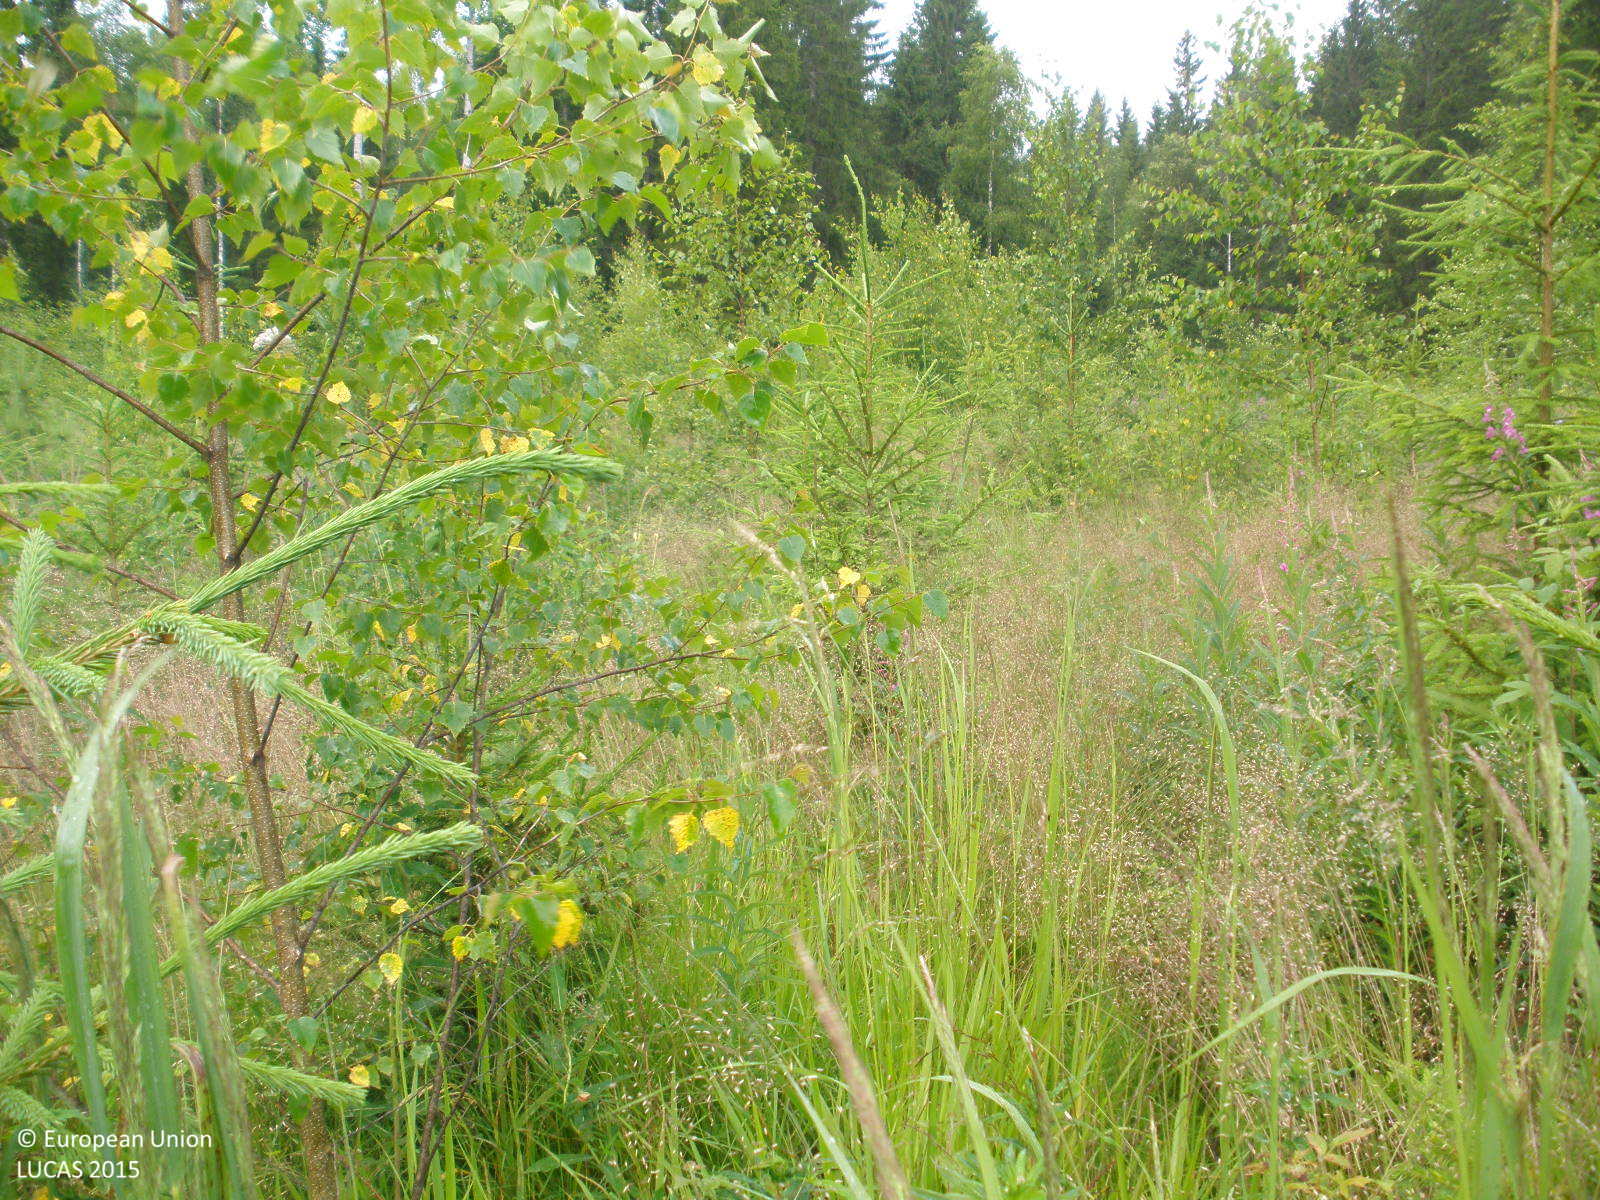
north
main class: Woodland
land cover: Other mixed woodland
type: boreal forest
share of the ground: 50 - 75 %
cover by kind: broadleaved forest trees 40 %, shrubs 35 %, coniferous forest trees 15 %, herbaceous plants 10 %
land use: Forestry
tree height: < 5 m
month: July
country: FI
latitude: 61.4213
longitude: 24.7398
